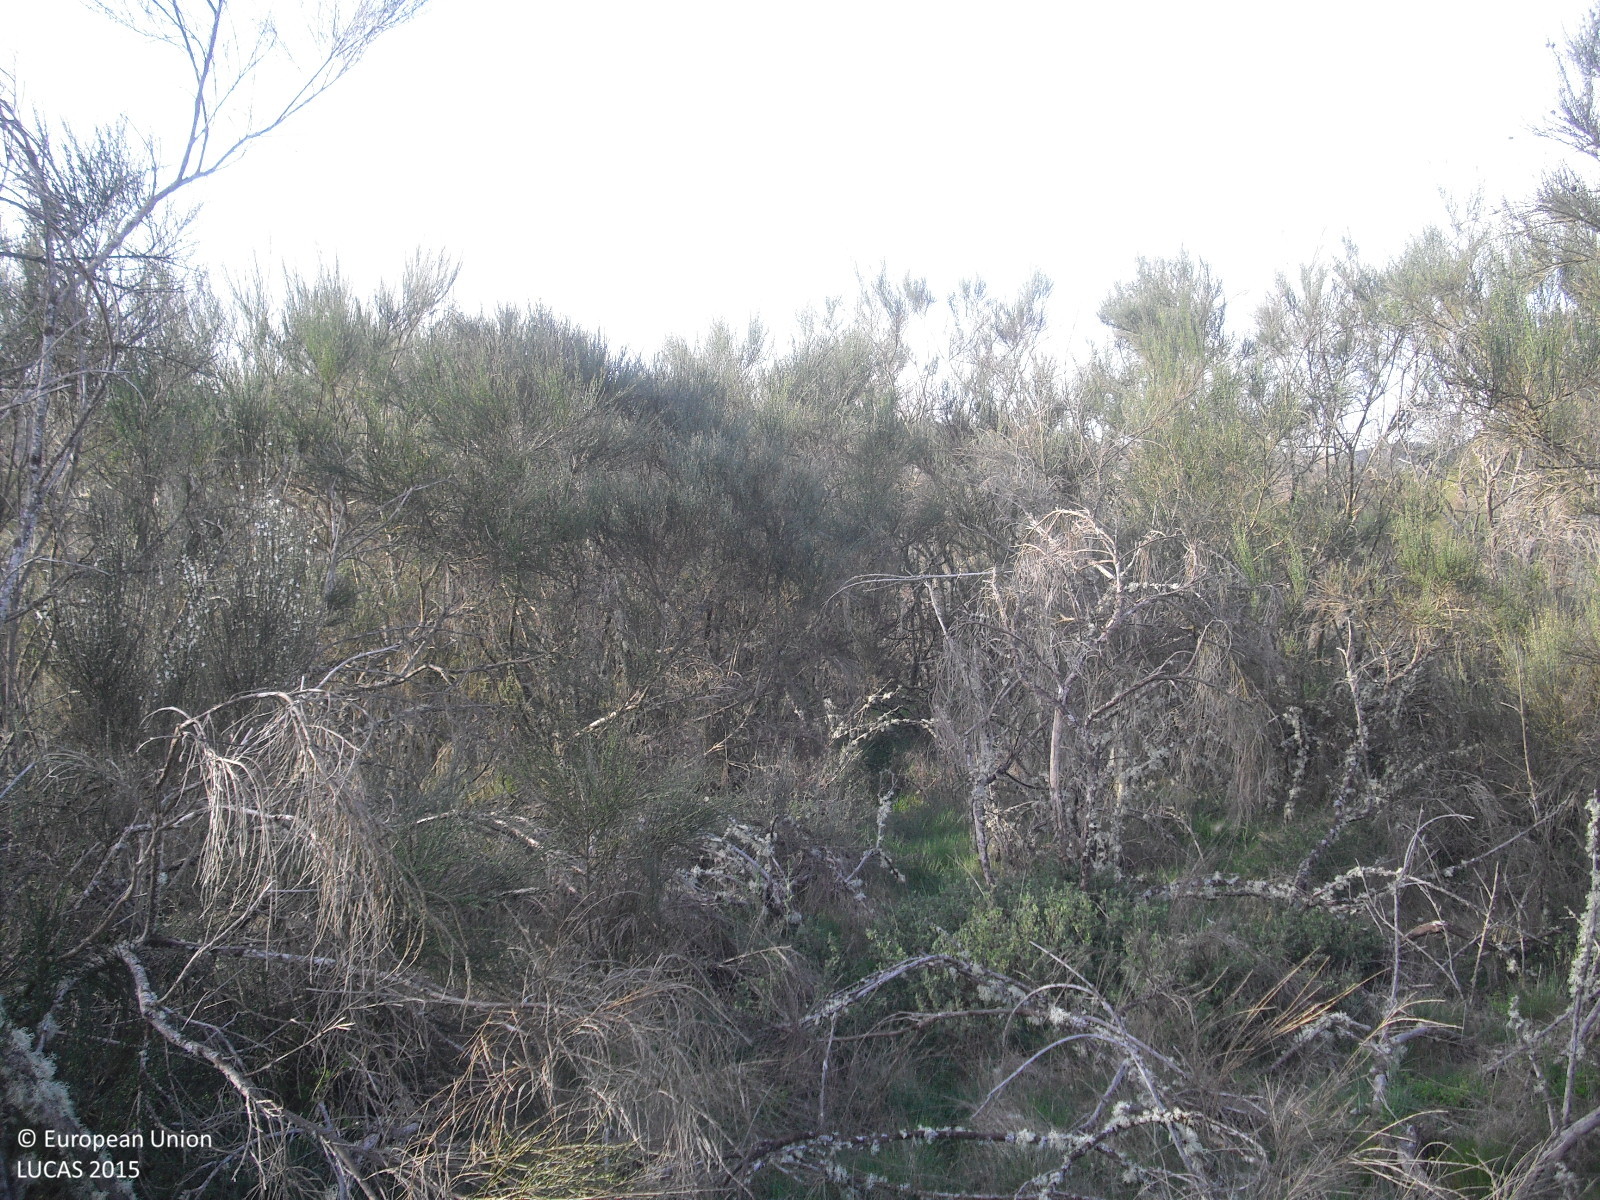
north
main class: Shrubland
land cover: Shrubland without tree cover
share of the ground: > 75 %
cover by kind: shrubs 70 %, herbaceous plants 30 %
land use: Abandoned areas
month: April
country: ES
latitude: 41.9224
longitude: -7.6337
